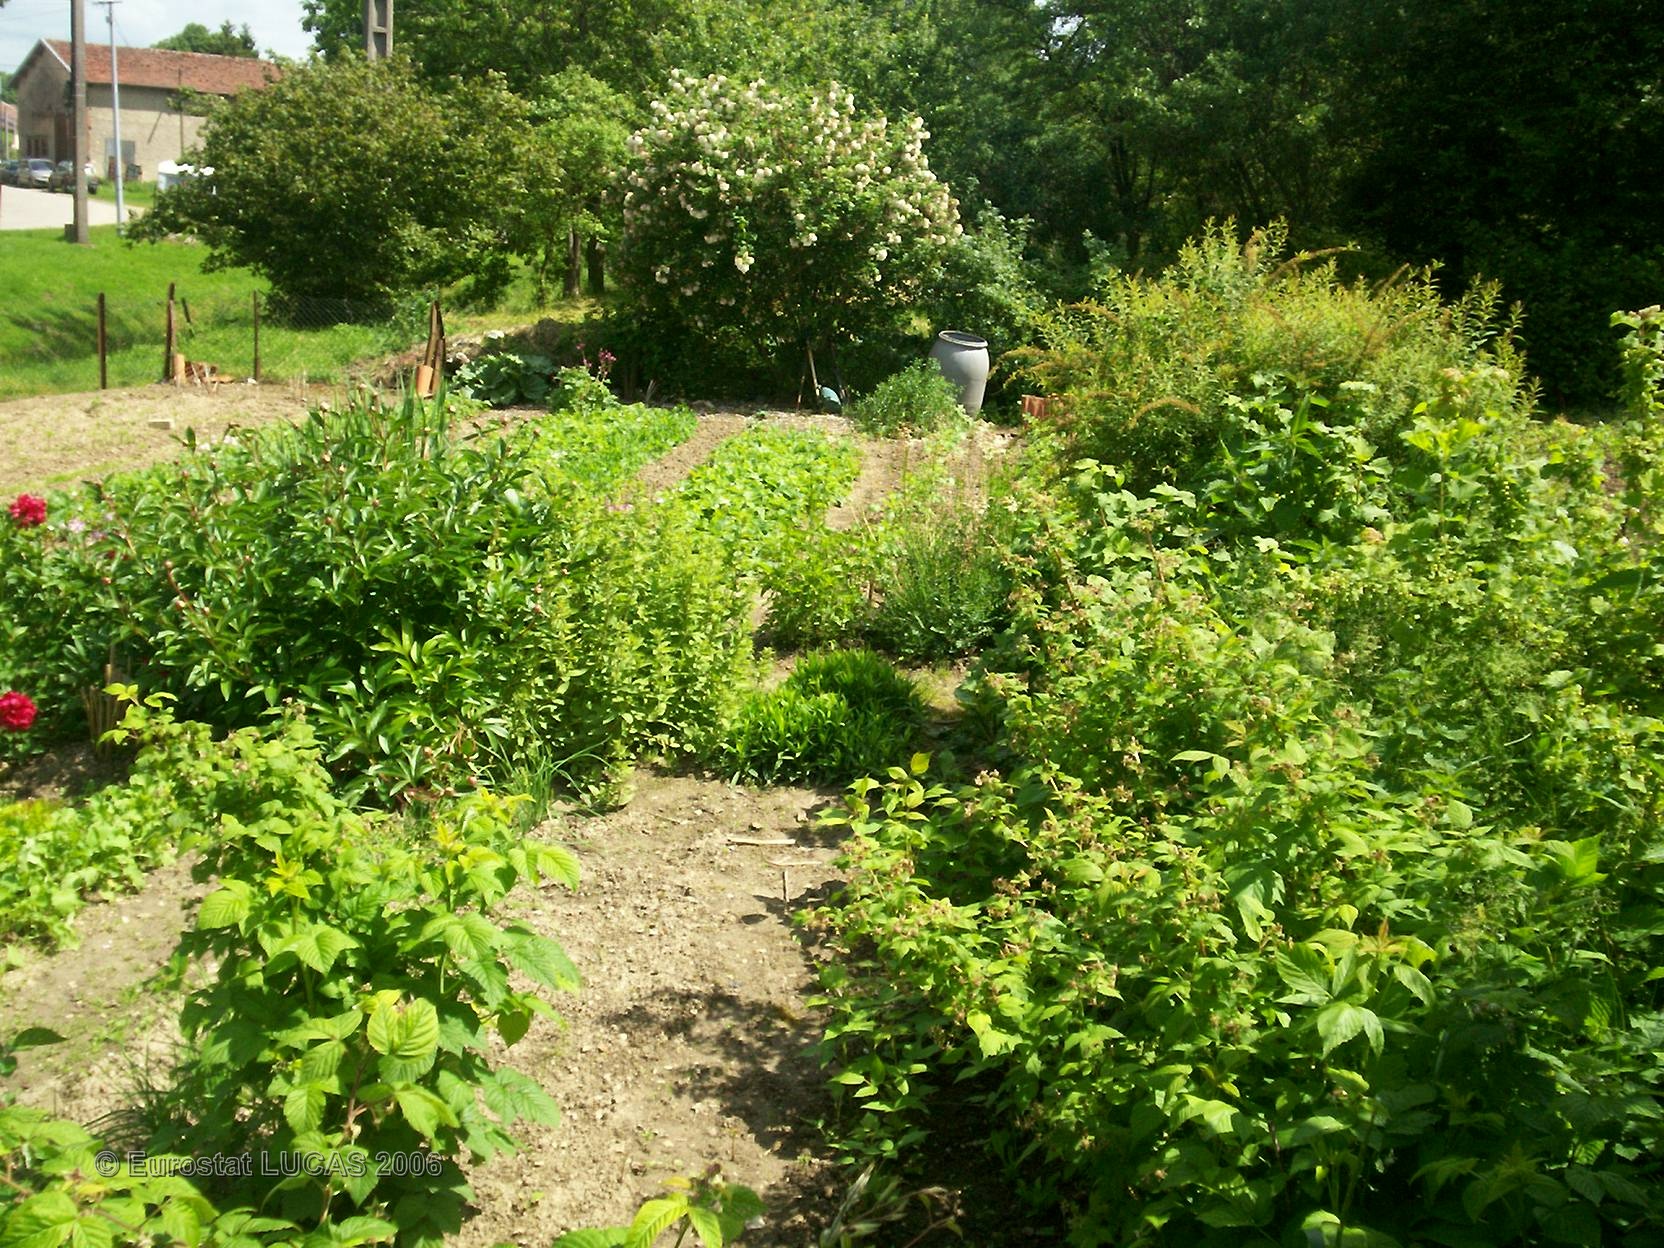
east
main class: Cropland
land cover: Other fresh vegetables
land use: Kitchen garden
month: June
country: FR
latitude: 49.2486
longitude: 5.0661
